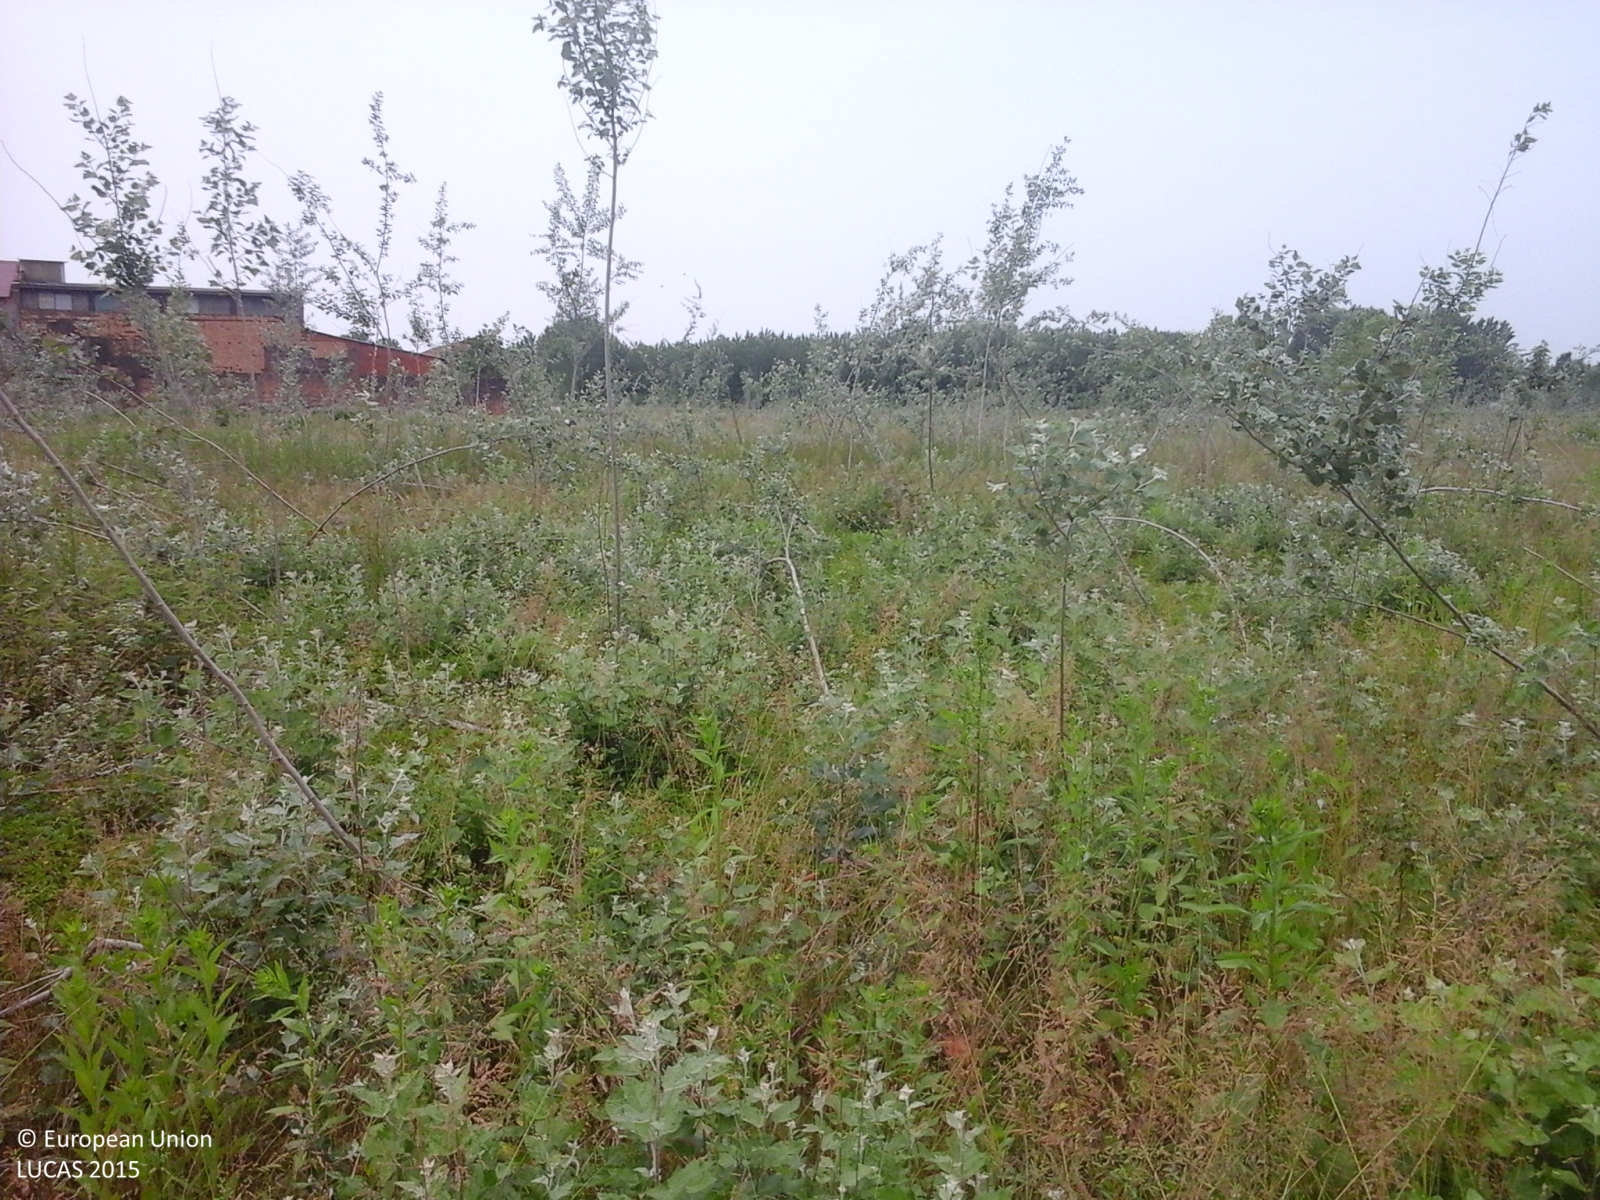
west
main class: Grassland
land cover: Grassland with sparse tree/shrub cover
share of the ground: > 75 %
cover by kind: herbaceous plants 90 %, broadleaved forest trees 5 %, shrubs 5 %
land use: Forestry
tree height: < 5 m
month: May
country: IT
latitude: 45.2863
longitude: 9.3764
